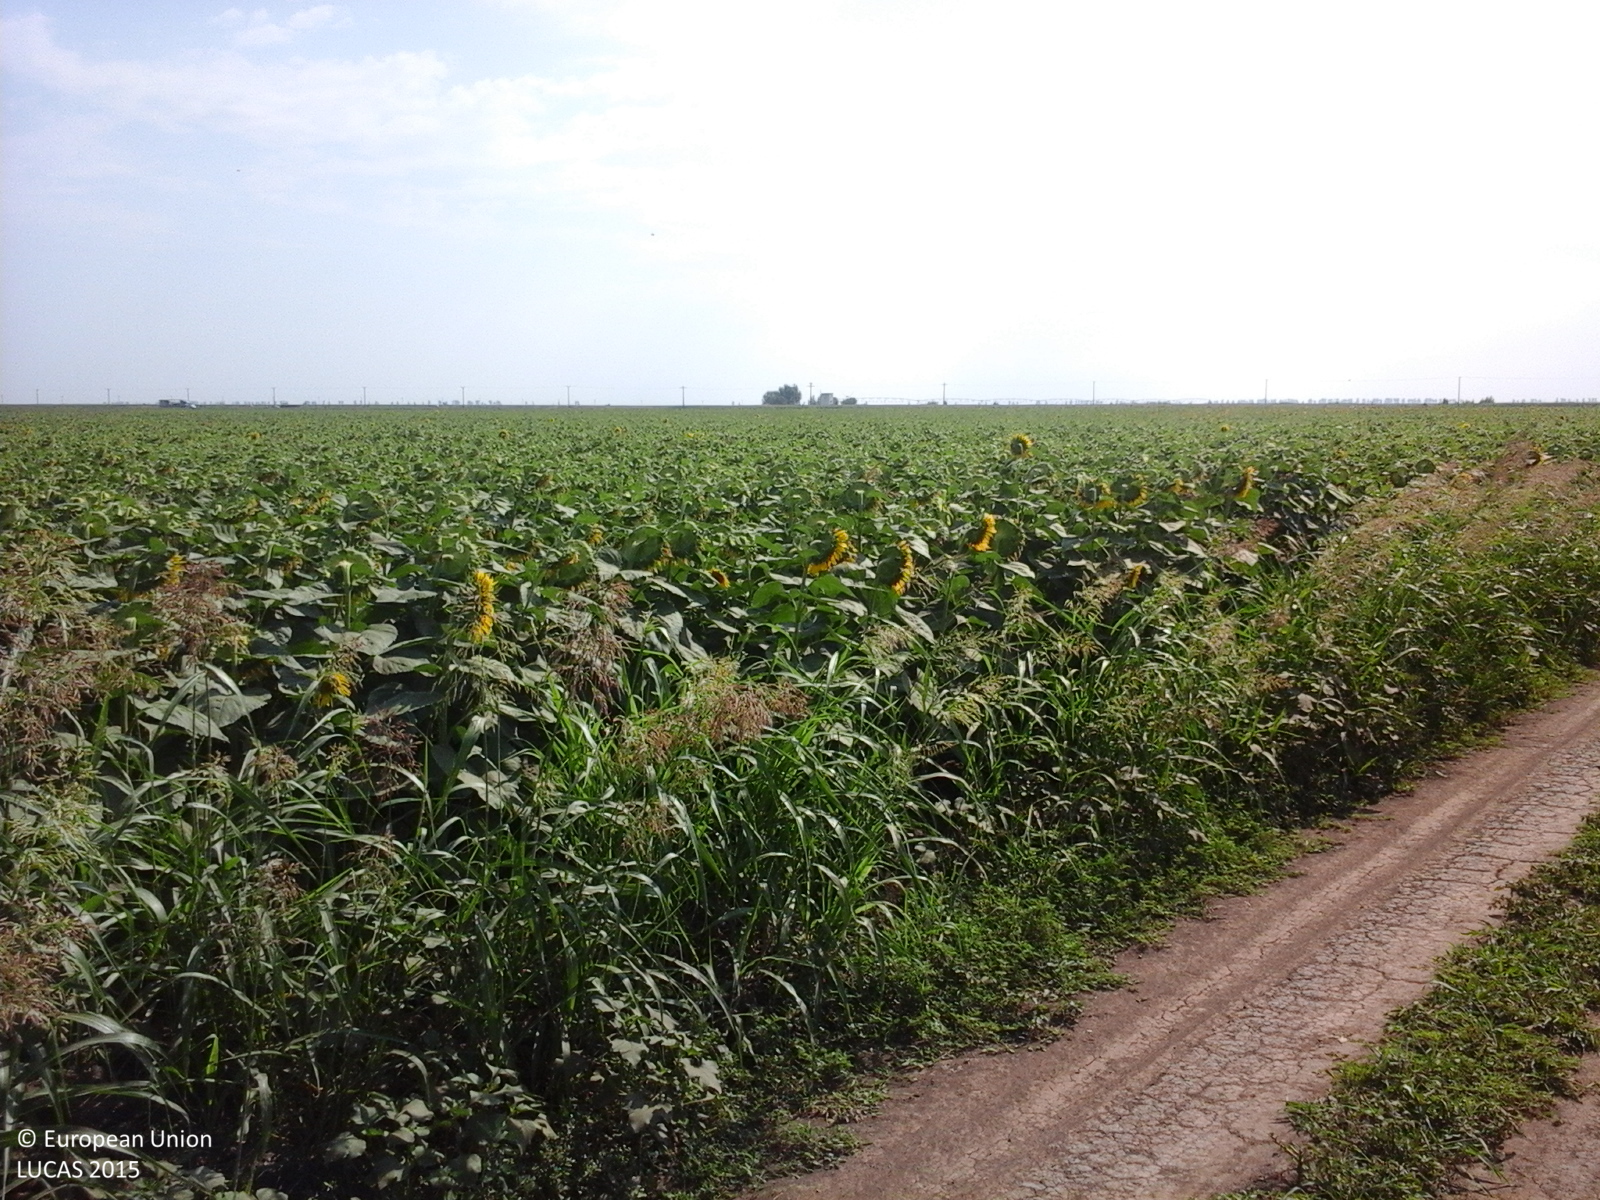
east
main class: Cropland
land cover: Maize
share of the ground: > 75 %
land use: Agriculture (excluding fallow land and kitchen gardens)
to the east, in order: Maize; Other fresh vegetables
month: July
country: RO
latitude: 44.6464
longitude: 27.2212
